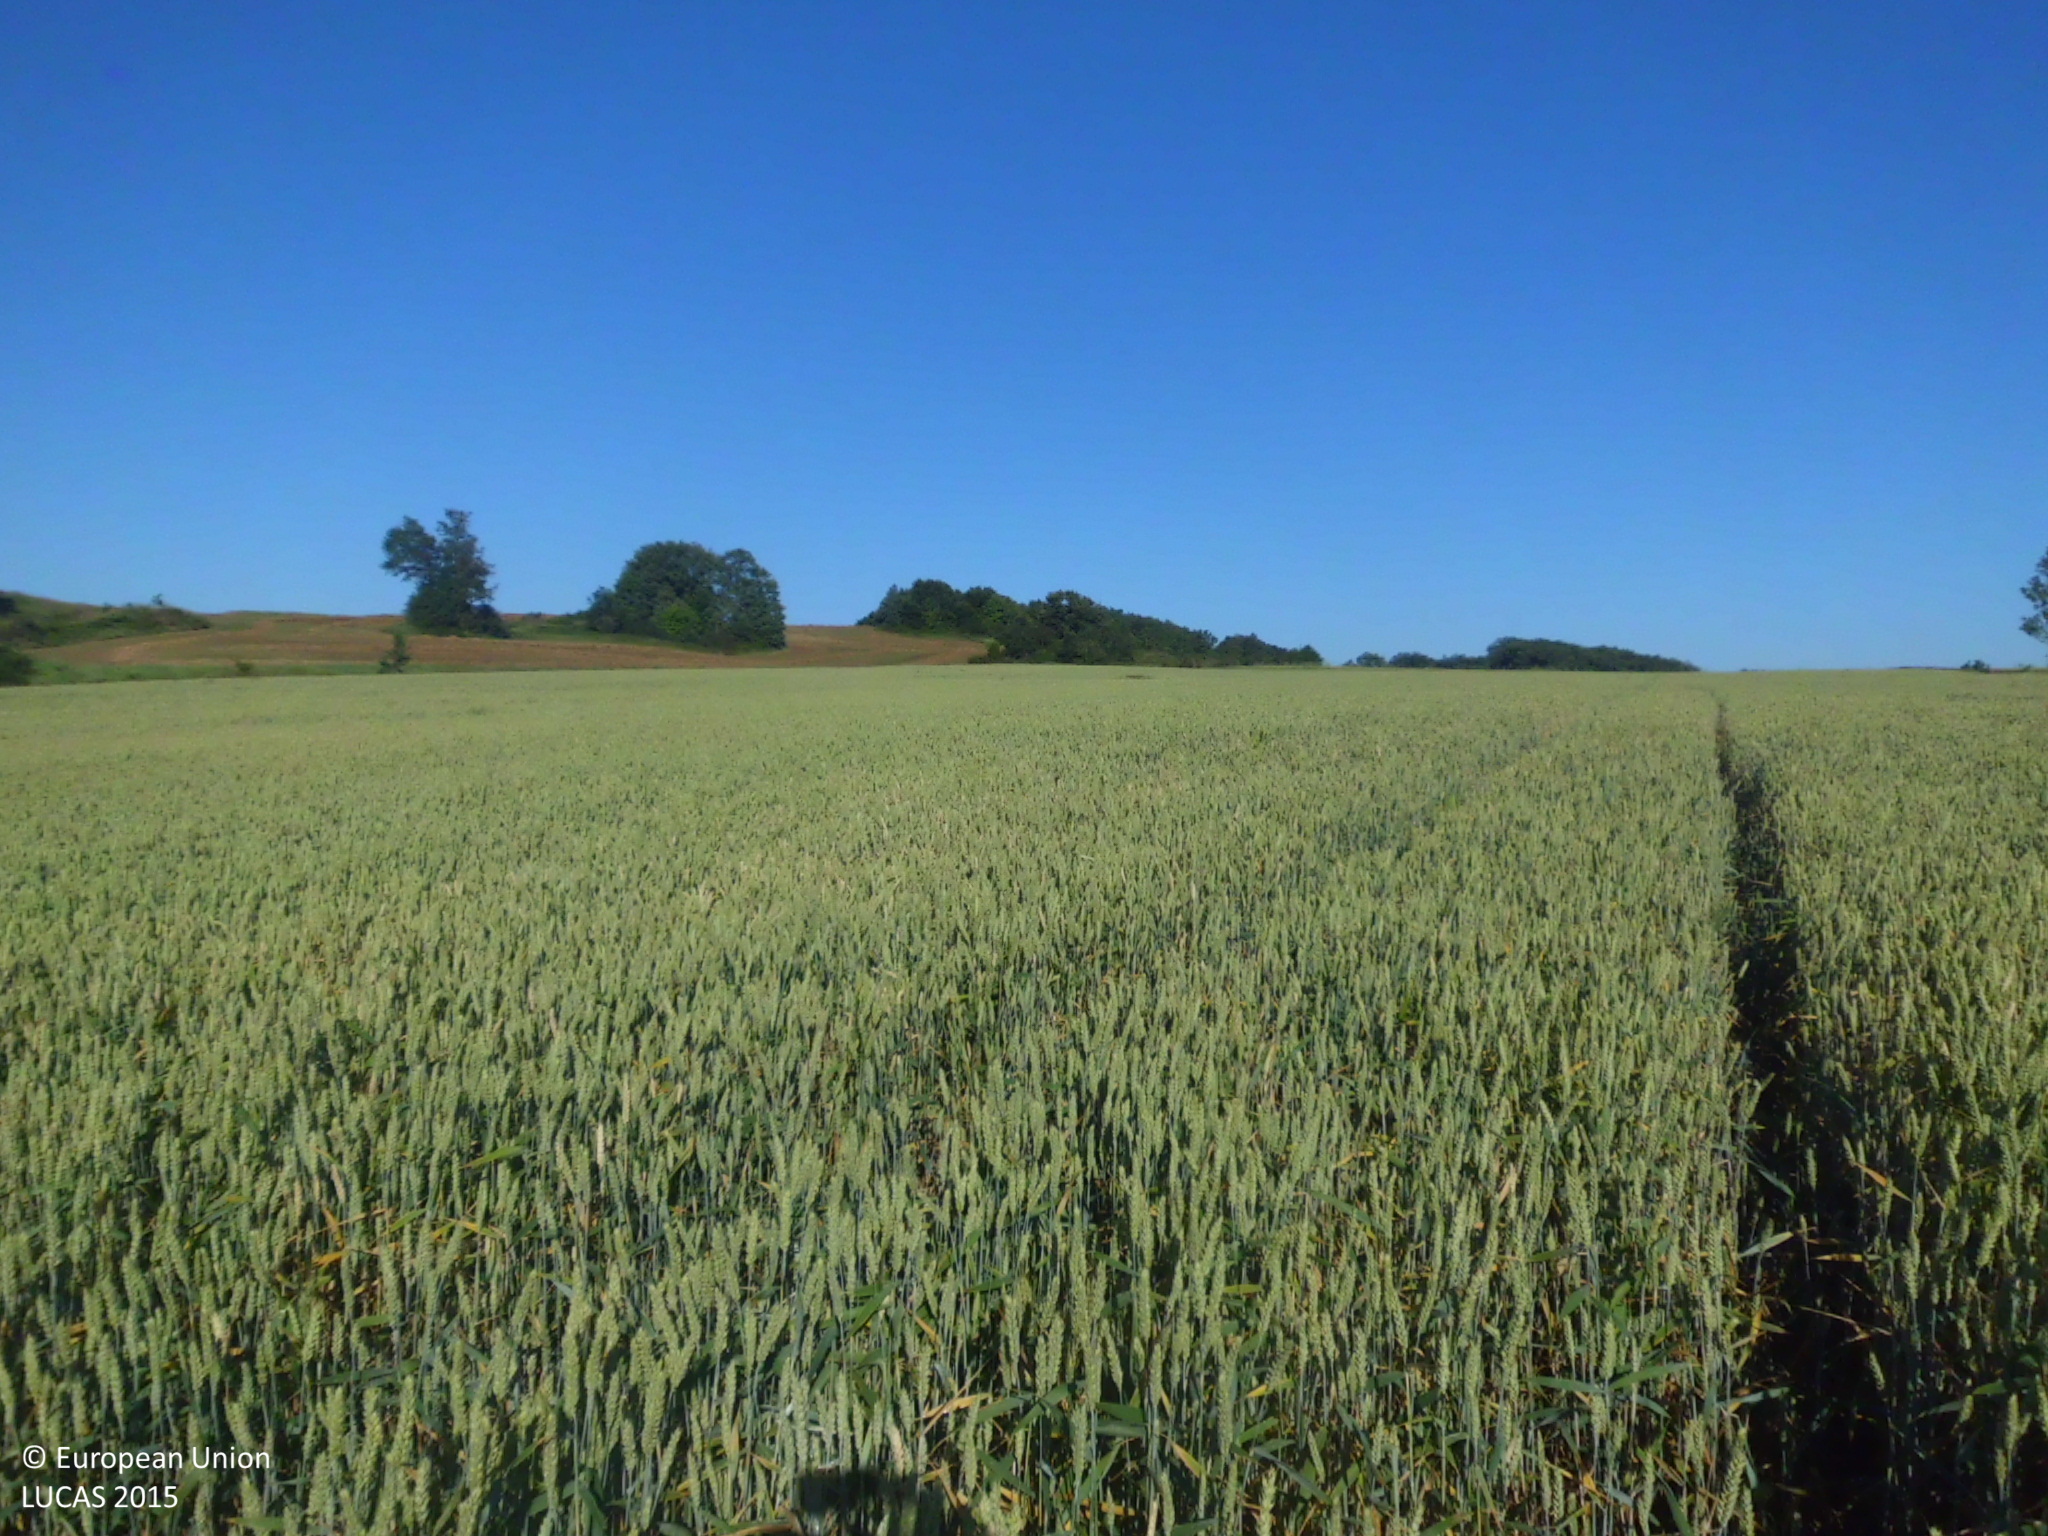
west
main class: Cropland
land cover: Common wheat
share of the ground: > 75 %
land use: Agriculture (excluding fallow land and kitchen gardens)
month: June
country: ES
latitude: 42.6548
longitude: -3.9375
